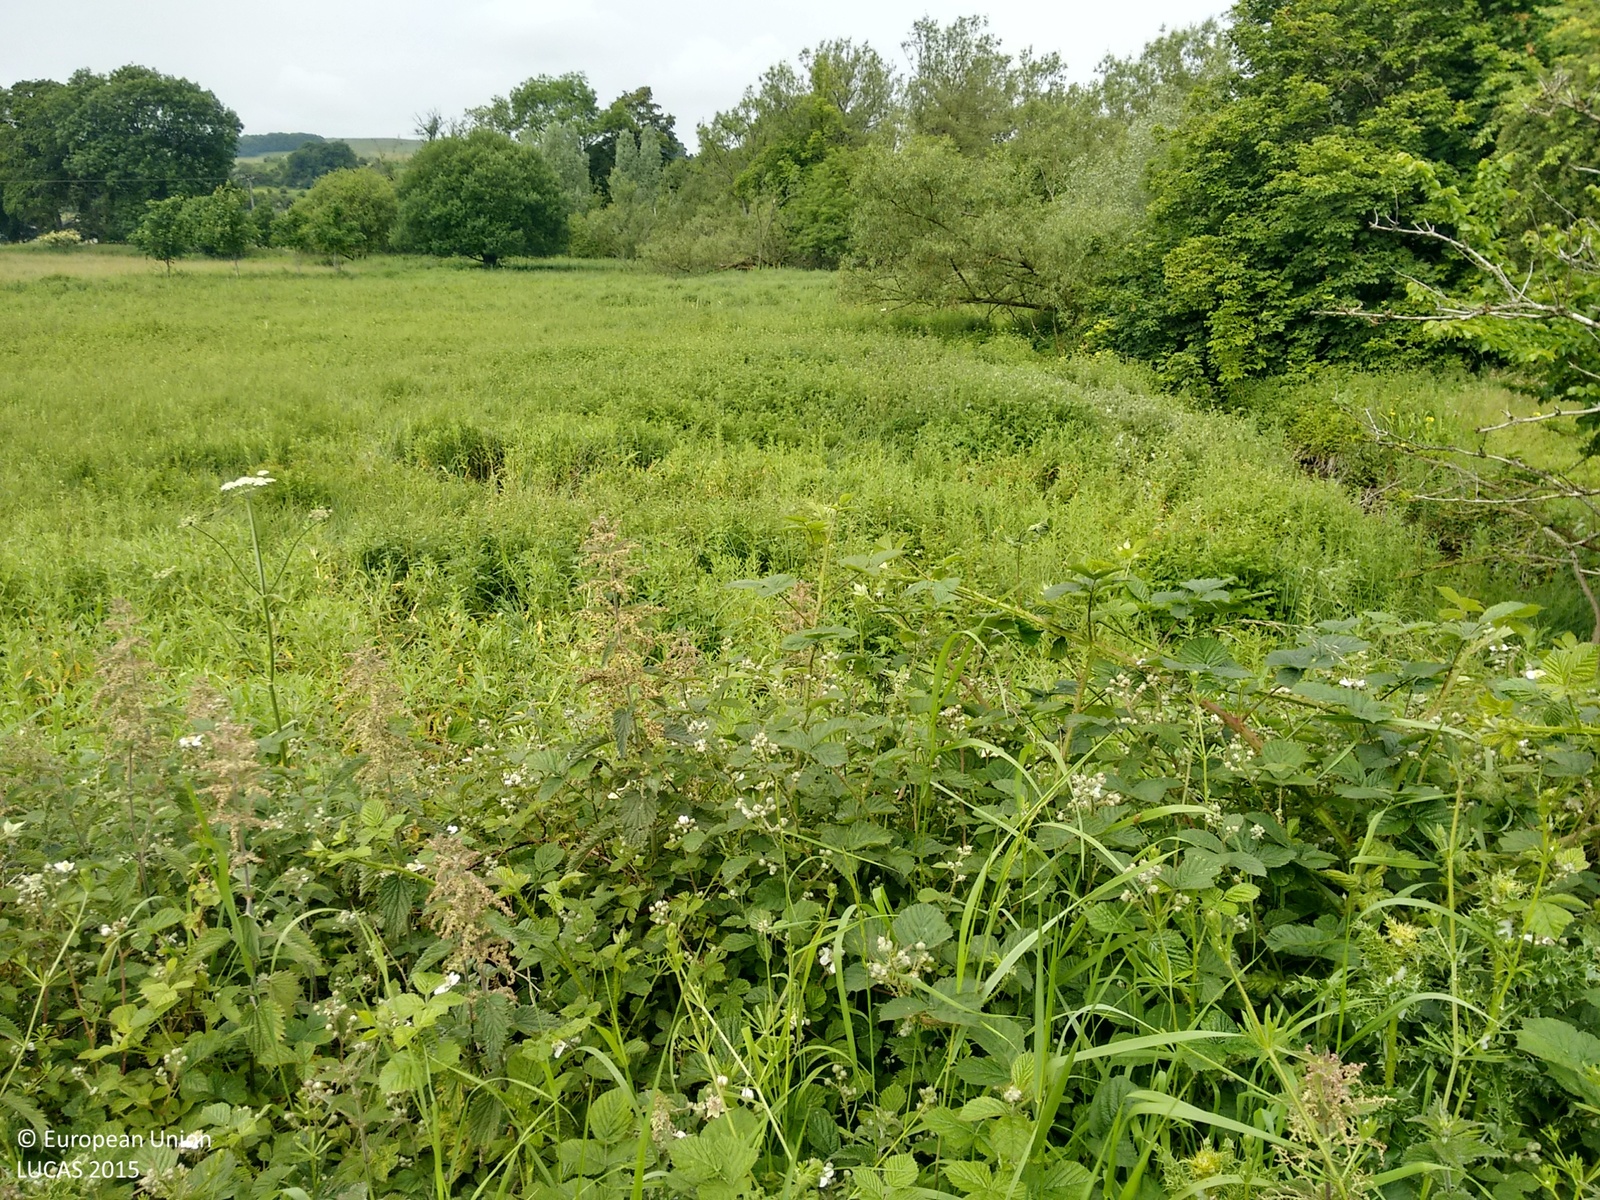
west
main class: Grassland
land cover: Grassland without tree/shrub cover
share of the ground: > 75 %
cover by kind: herbaceous plants 100 %
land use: Agriculture (excluding fallow land and kitchen gardens)
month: June
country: GB
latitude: 53.2741
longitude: -1.6441
